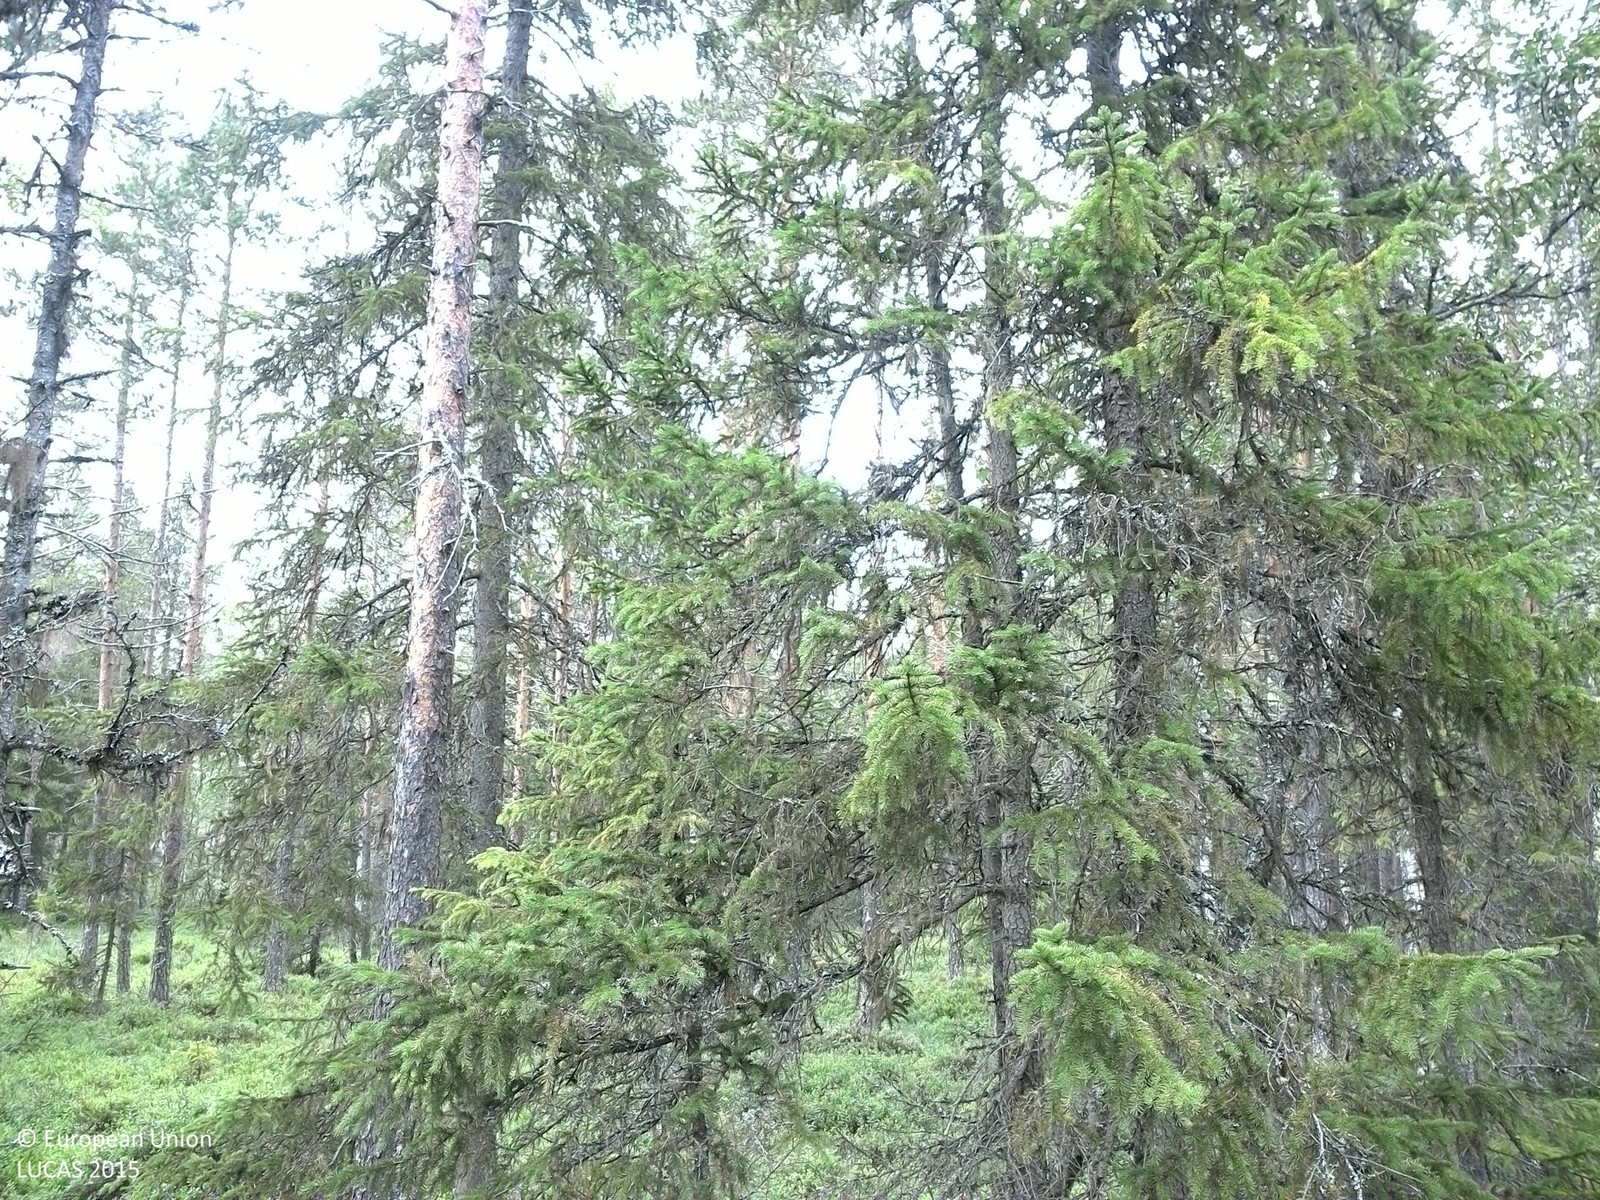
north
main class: Woodland
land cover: Pine dominated coniferous woodland
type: boreal forest
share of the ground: 25 - 50 %
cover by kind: shrubs 50 %, coniferous forest trees 35 %, broadleaved forest trees 5 %, herbaceous plants 5 %, lichens and mosses 5 %
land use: Forestry
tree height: > 5 m
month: July
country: SE
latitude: 62.8341
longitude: 16.9078
